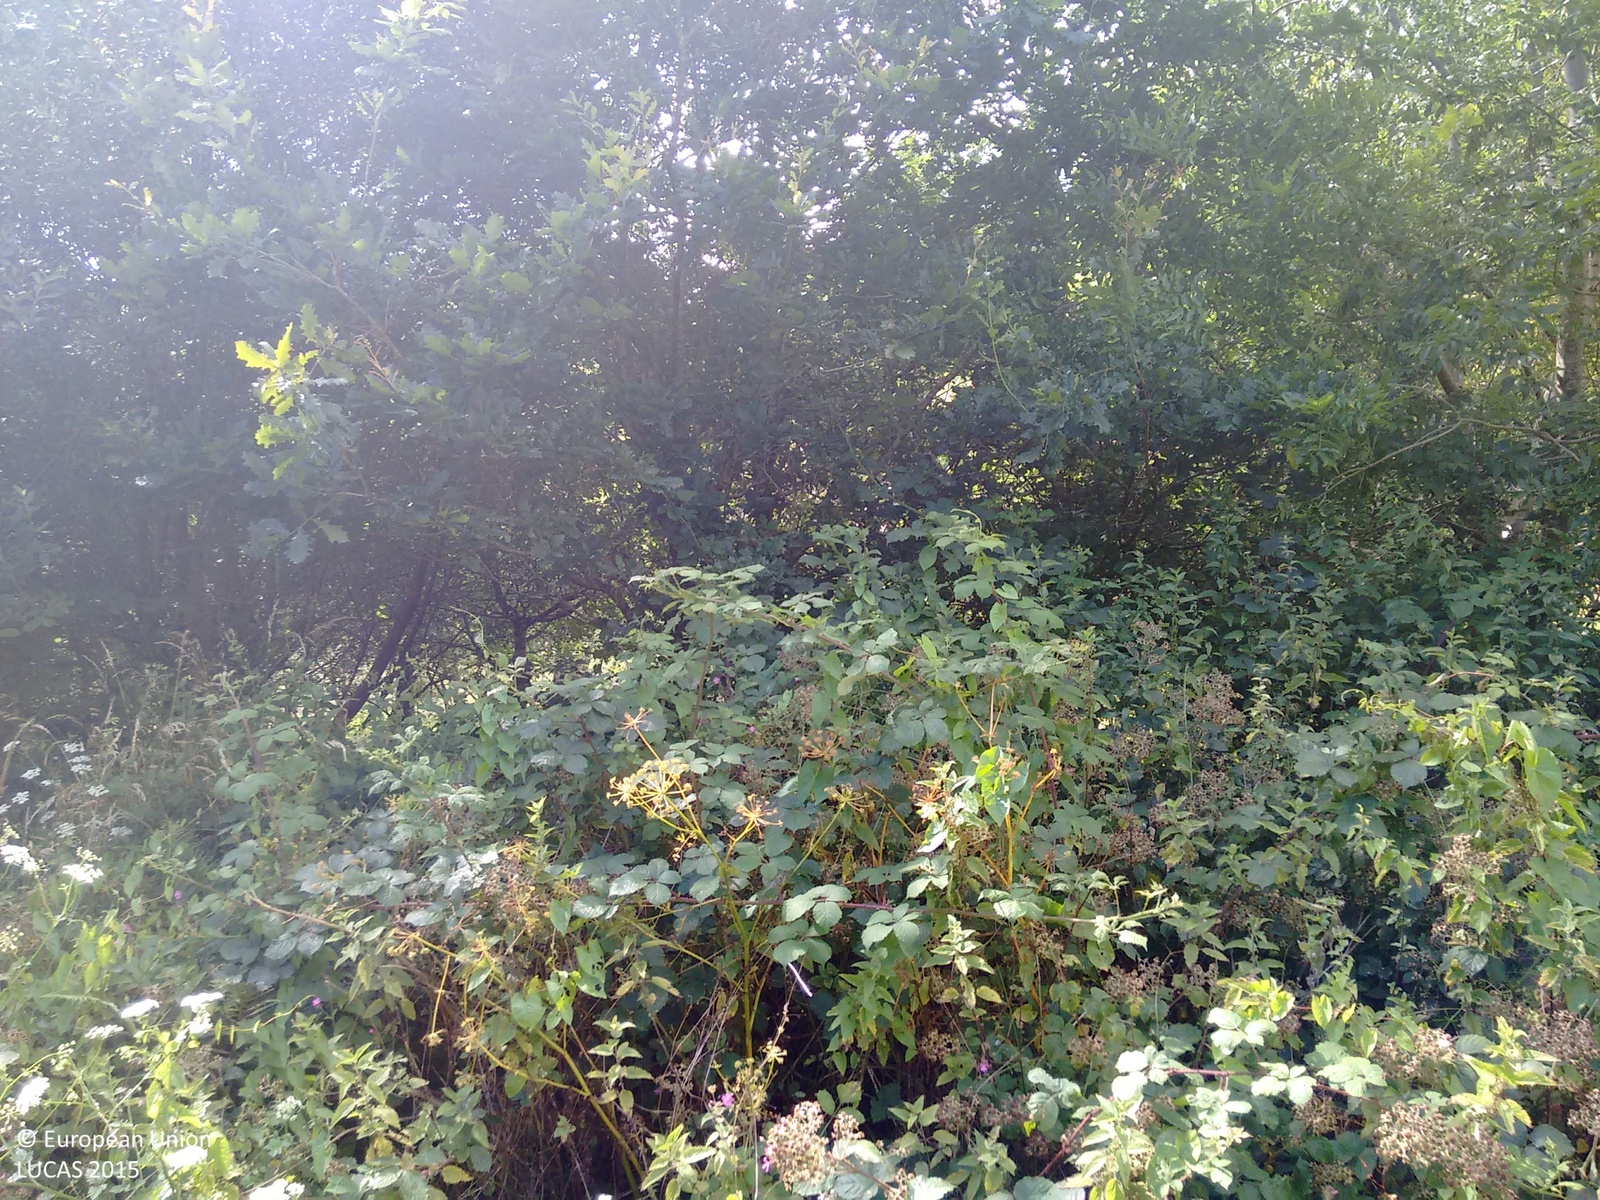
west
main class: Shrubland
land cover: Shrubland without tree cover
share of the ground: > 75 %
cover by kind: shrubs 80 %, herbaceous plants 20 %
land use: Semi-natural and natural areas not in use
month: August
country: GB
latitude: 50.3631
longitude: -3.9389
